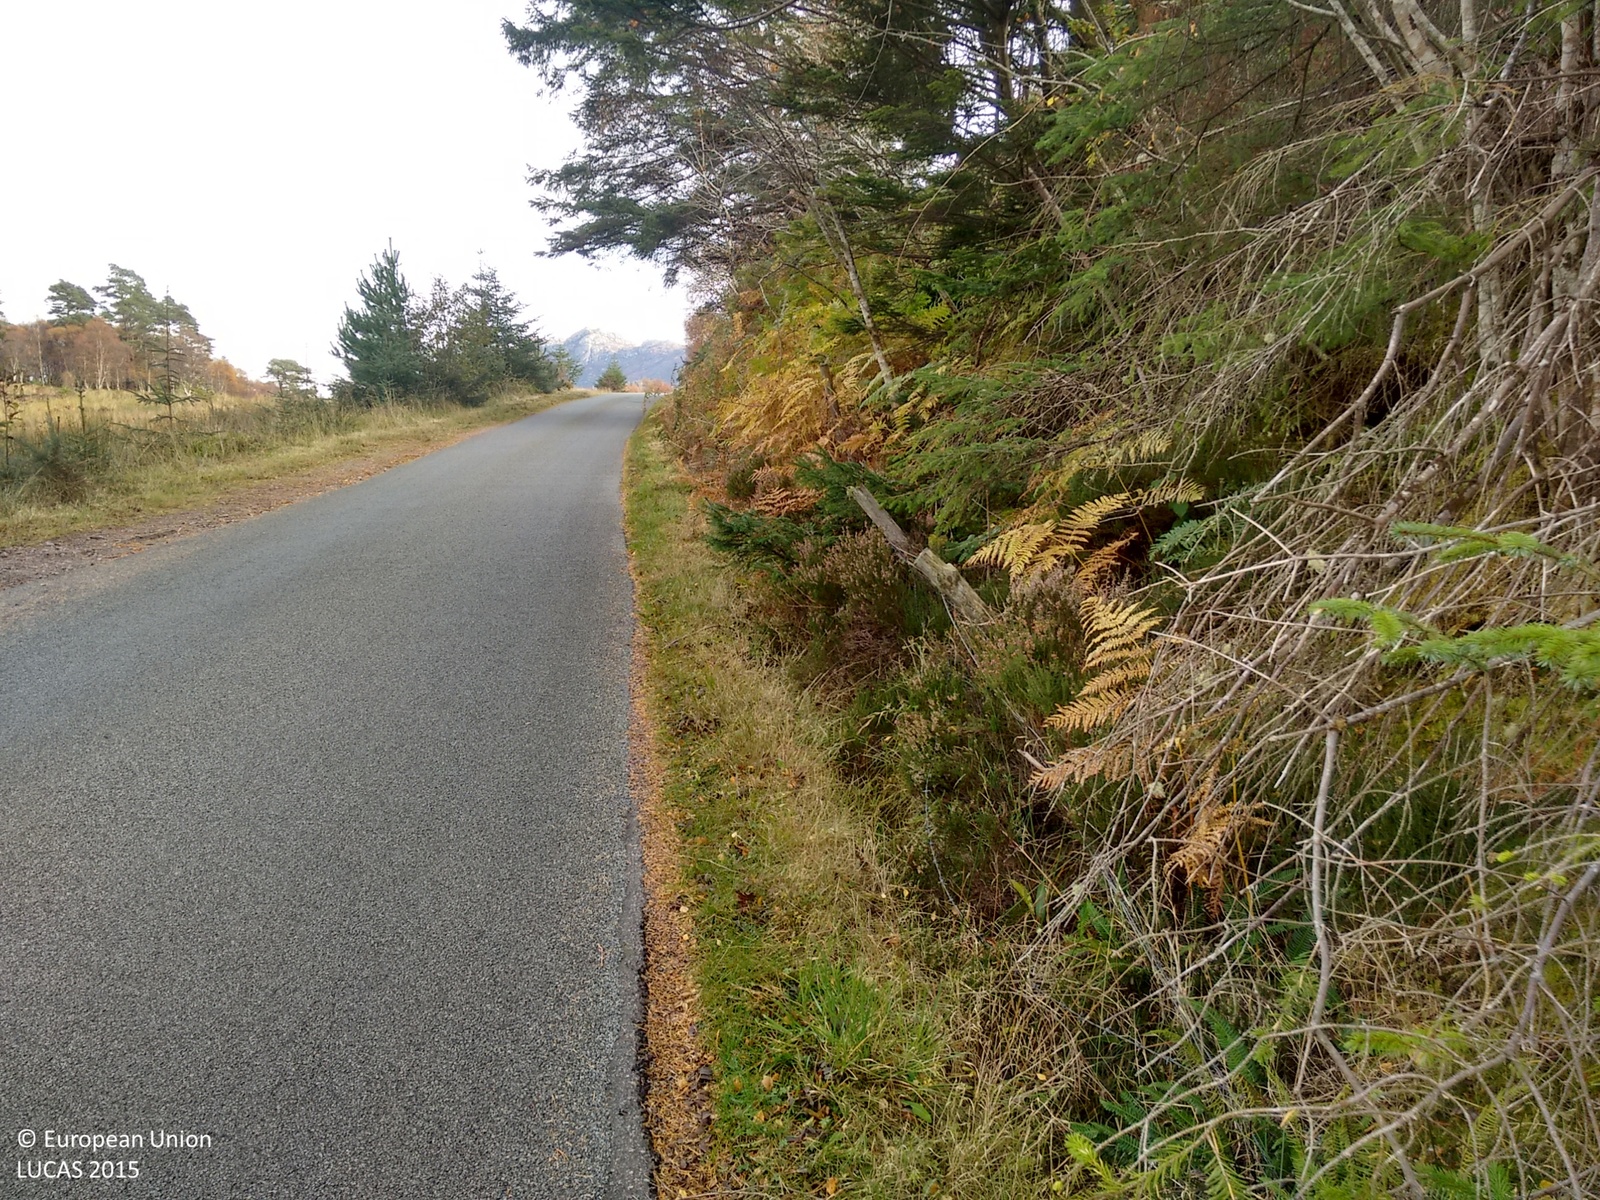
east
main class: Woodland
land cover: Spruce dominated coniferous woodland
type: exotic forest
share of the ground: > 75 %
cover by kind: coniferous forest trees 80 %, shrubs 10 %, herbaceous plants 10 %
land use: Forestry
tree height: > 5 m
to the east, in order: Spruce dominated coniferous woodland; Spruce dominated mixed woodland; Spruce dominated coniferous woodland
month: November
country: GB
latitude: 57.3306
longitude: -5.6506
